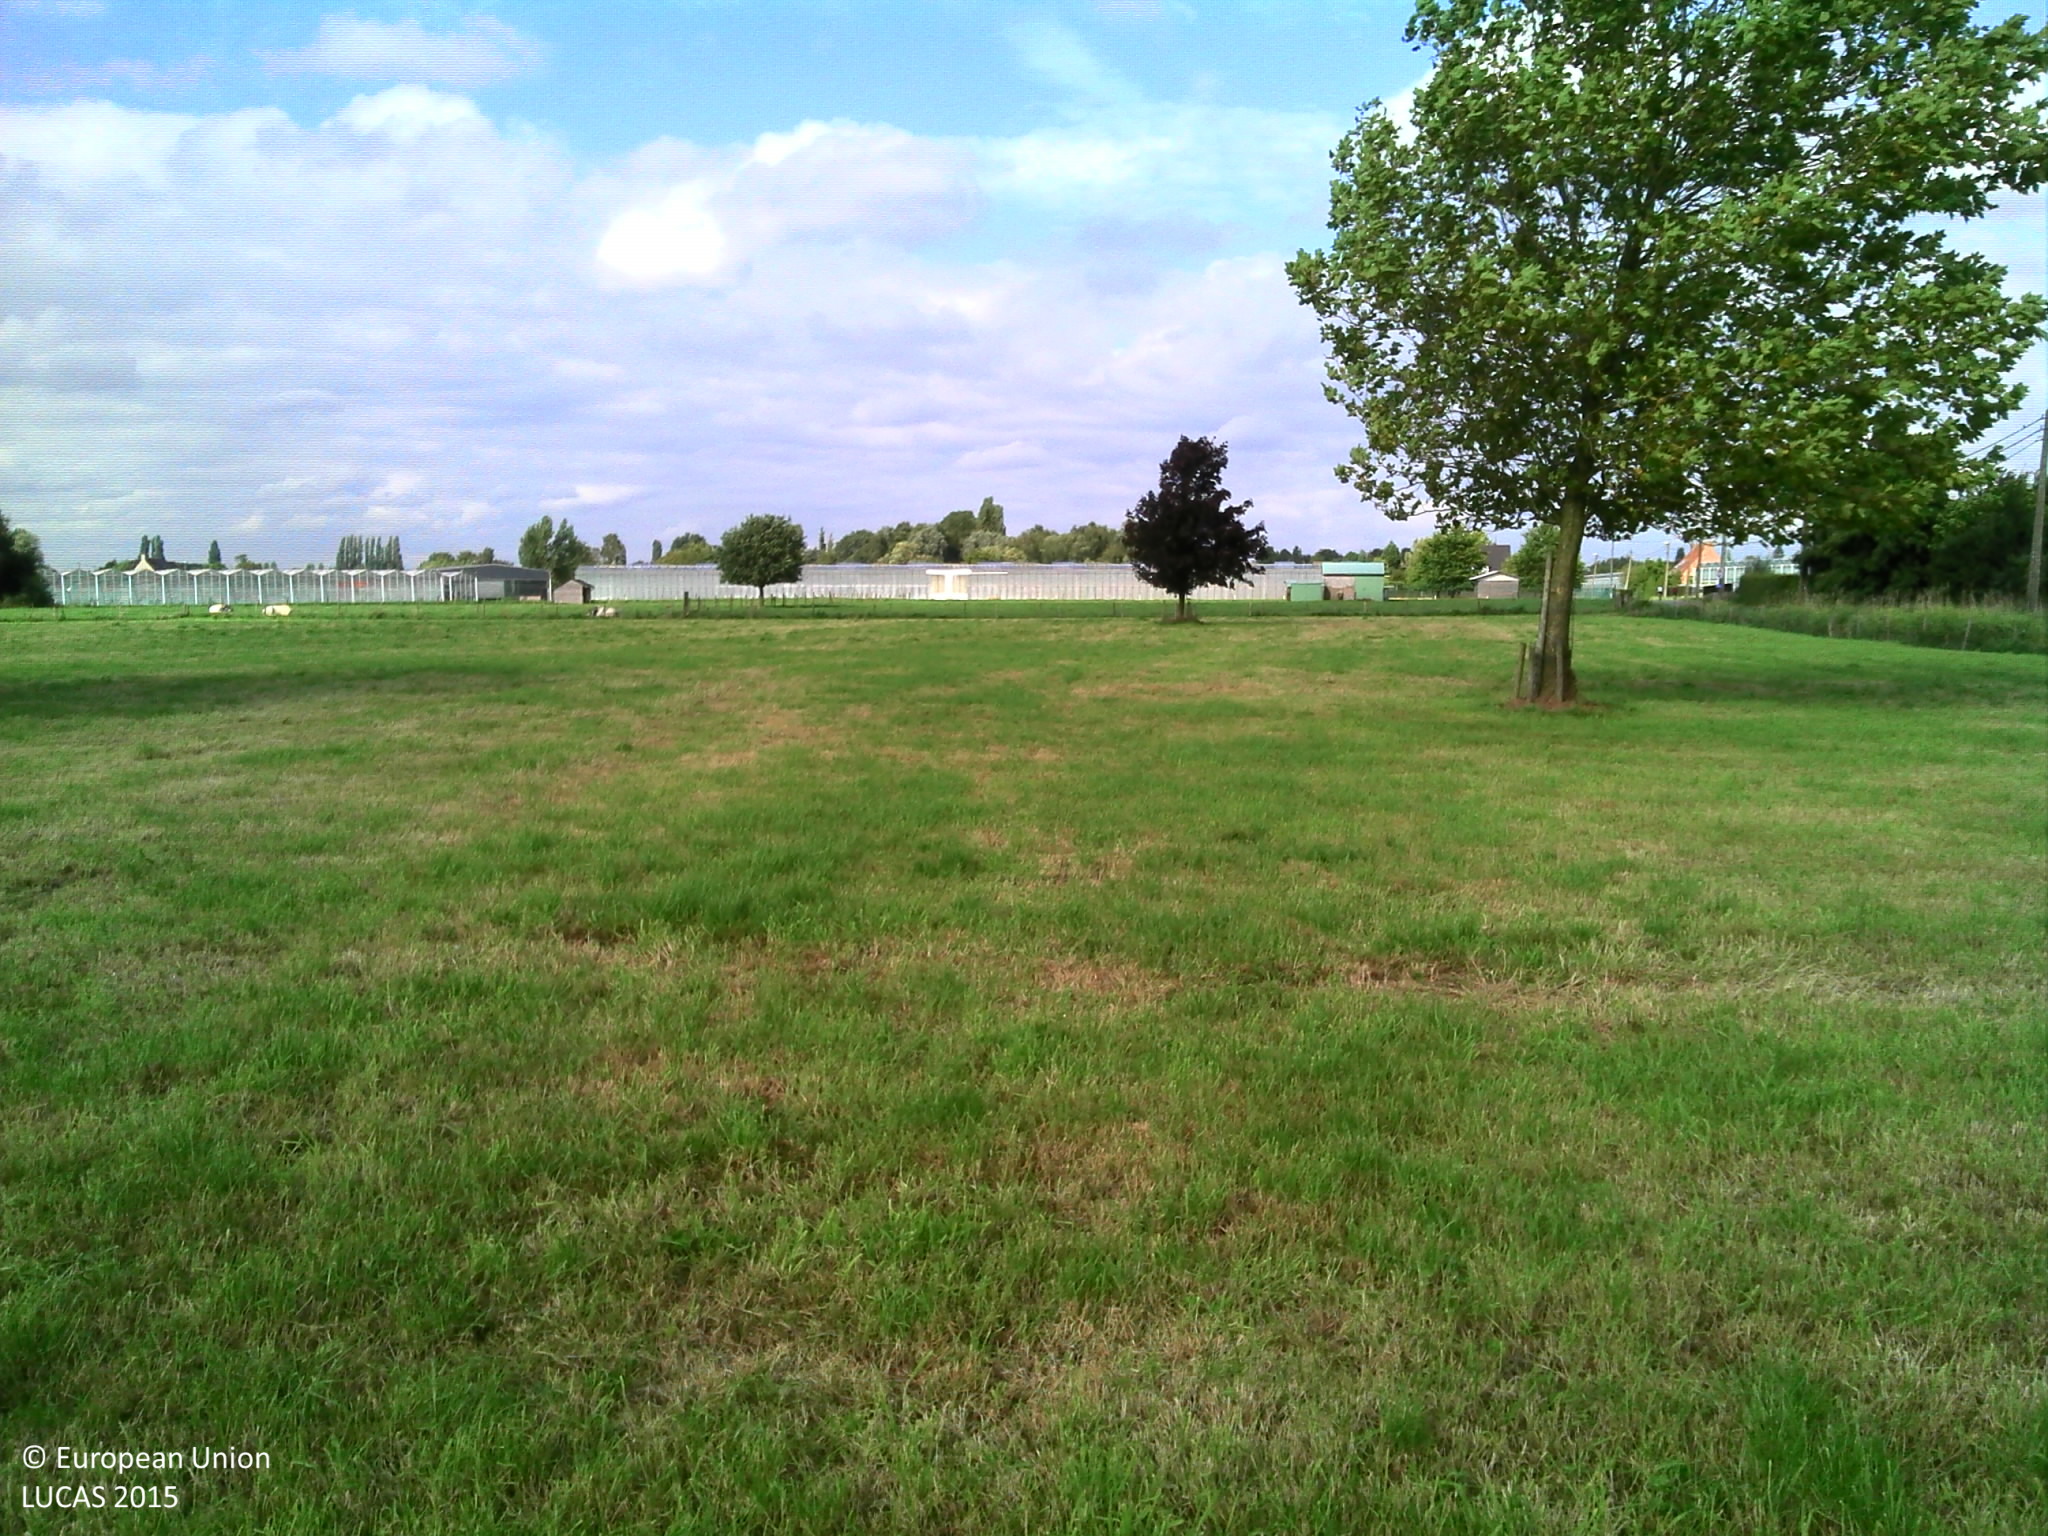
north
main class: Grassland
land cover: Grassland without tree/shrub cover
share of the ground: > 75 %
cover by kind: herbaceous plants 100 %
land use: Agriculture (excluding fallow land and kitchen gardens)
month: September
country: BE
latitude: 51.1877
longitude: 4.5160
